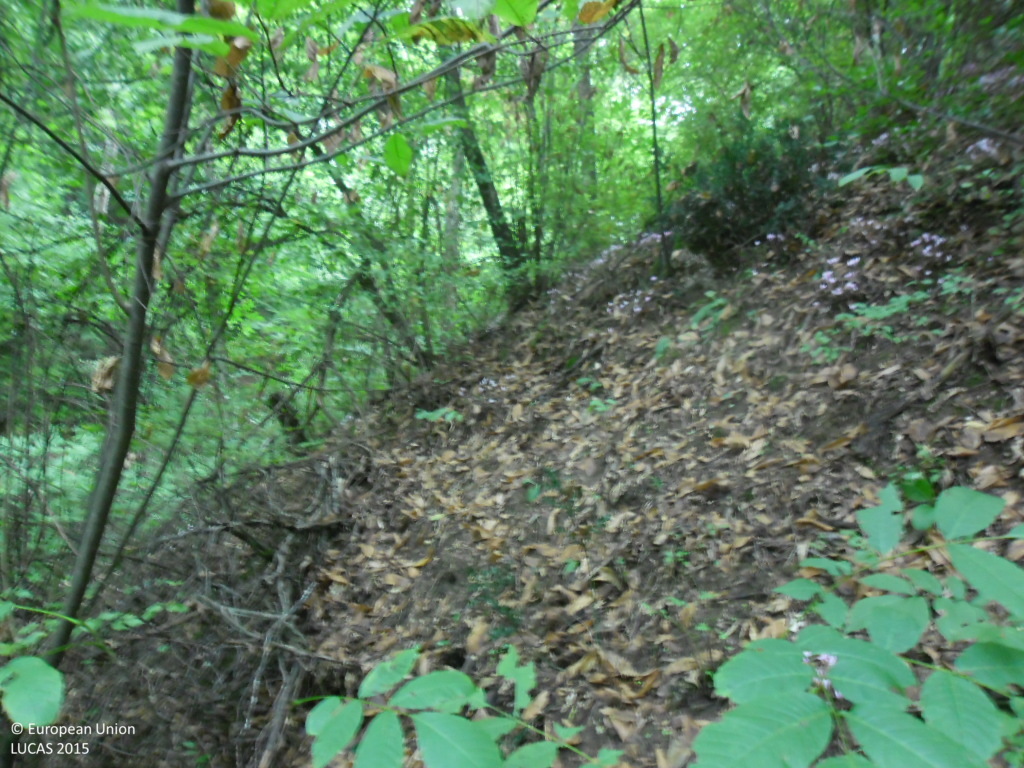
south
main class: Woodland
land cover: Broadleaved woodland
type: mesophytic deciduous forest
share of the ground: > 75 %
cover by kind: broadleaved forest trees 95 %, unconsolidated bare surface 5 %
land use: Forestry
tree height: > 5 m
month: September
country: BG
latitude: 41.3659
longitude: 23.0595
